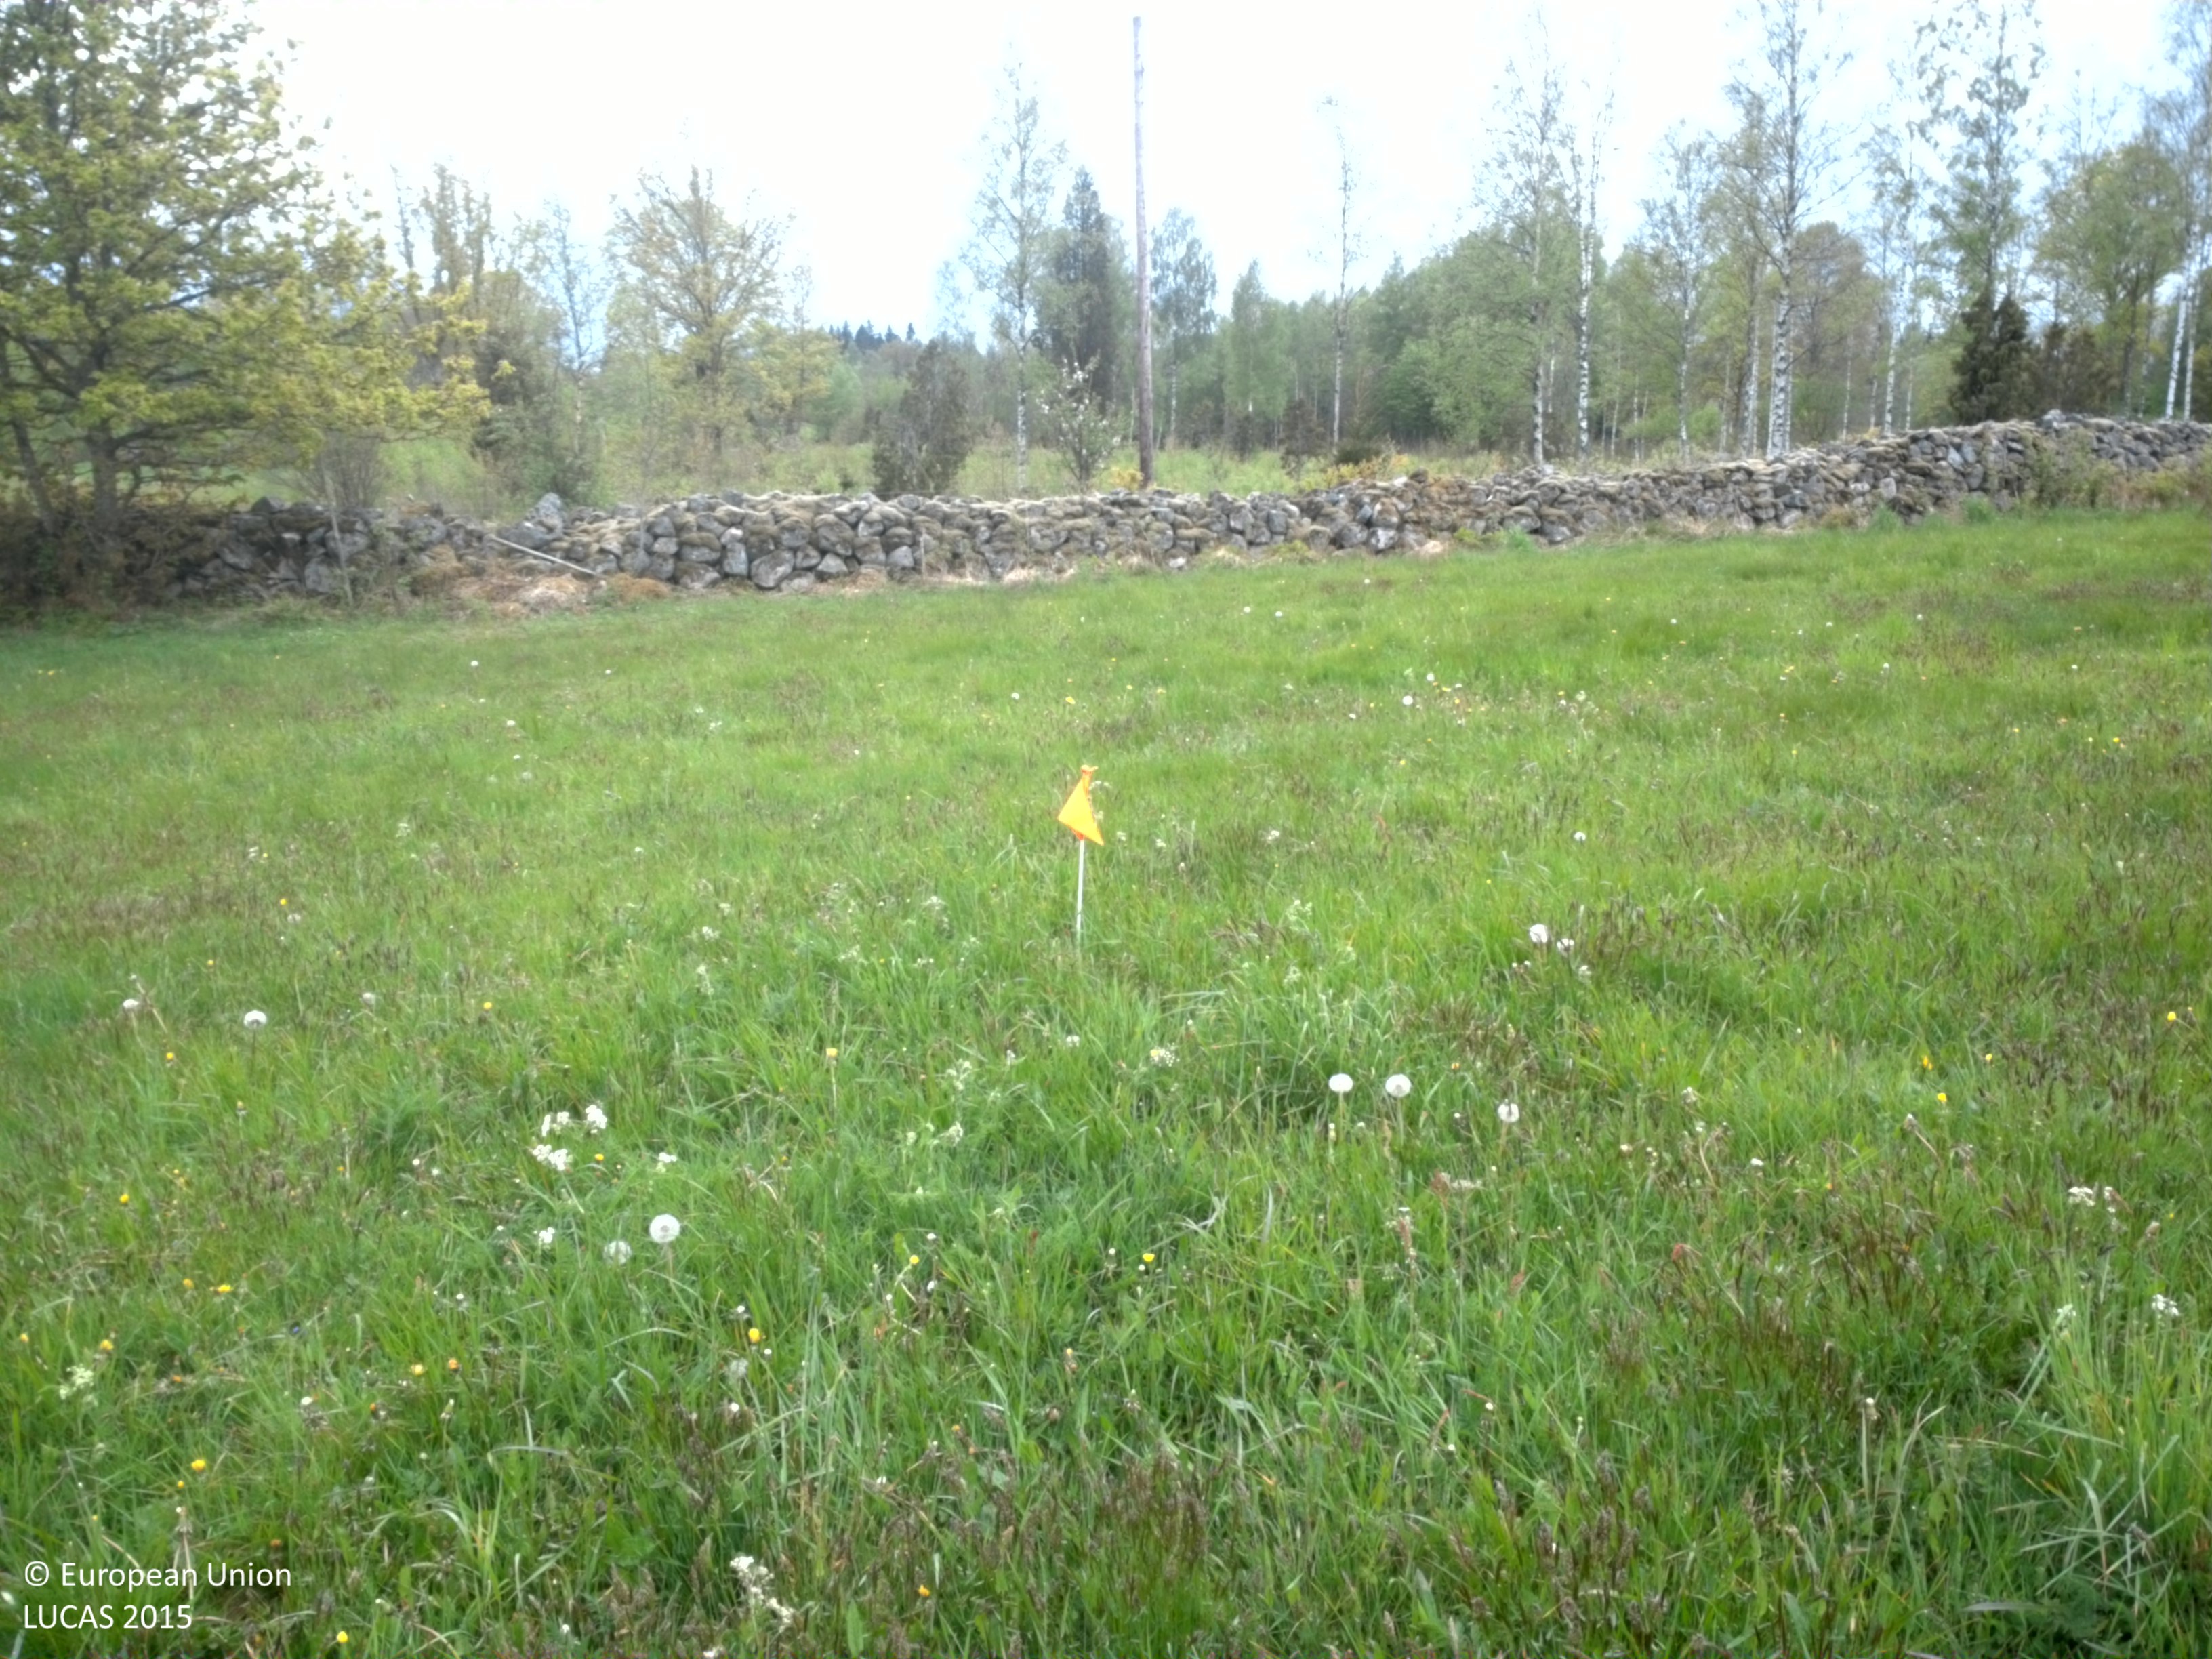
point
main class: Grassland
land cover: Grassland without tree/shrub cover
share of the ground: > 75 %
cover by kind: herbaceous plants 100 %
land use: Agriculture (excluding fallow land and kitchen gardens)
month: May
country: SE
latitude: 56.5706
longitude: 15.1576
